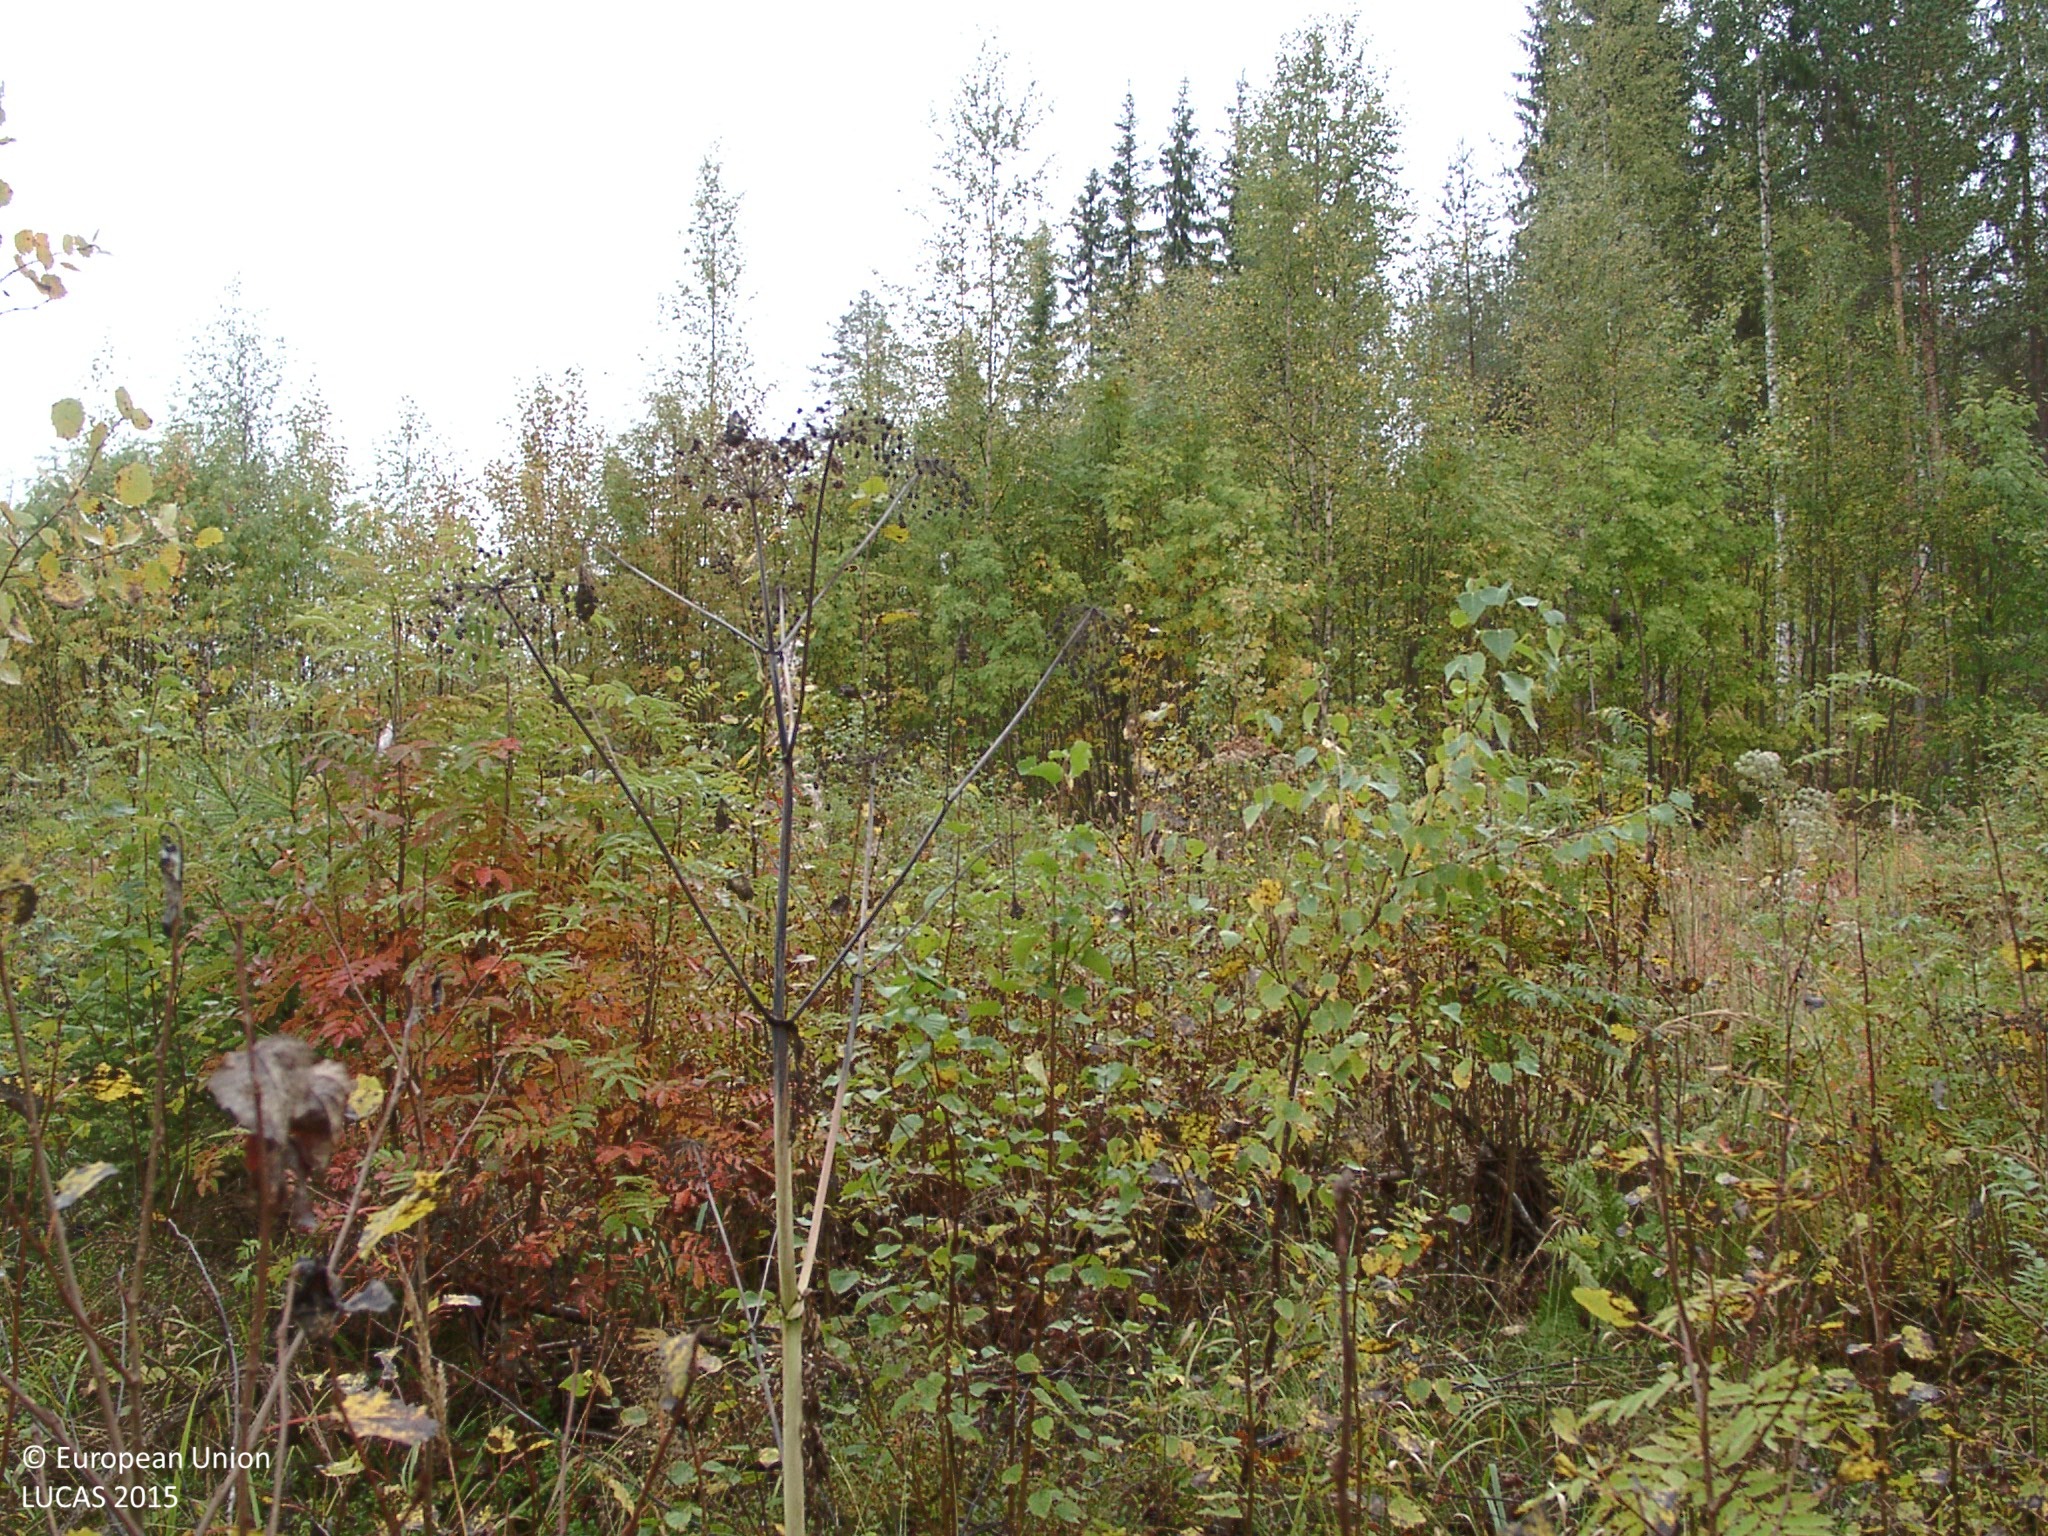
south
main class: Woodland
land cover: Broadleaved woodland
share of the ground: 25 - 50 %
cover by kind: herbaceous plants 60 %, broadleaved forest trees 35 %, shrubs 5 %
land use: Electricity, gas and thermal power distribution
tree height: < 5 m
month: September
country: FI
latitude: 62.5861
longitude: 25.5907
